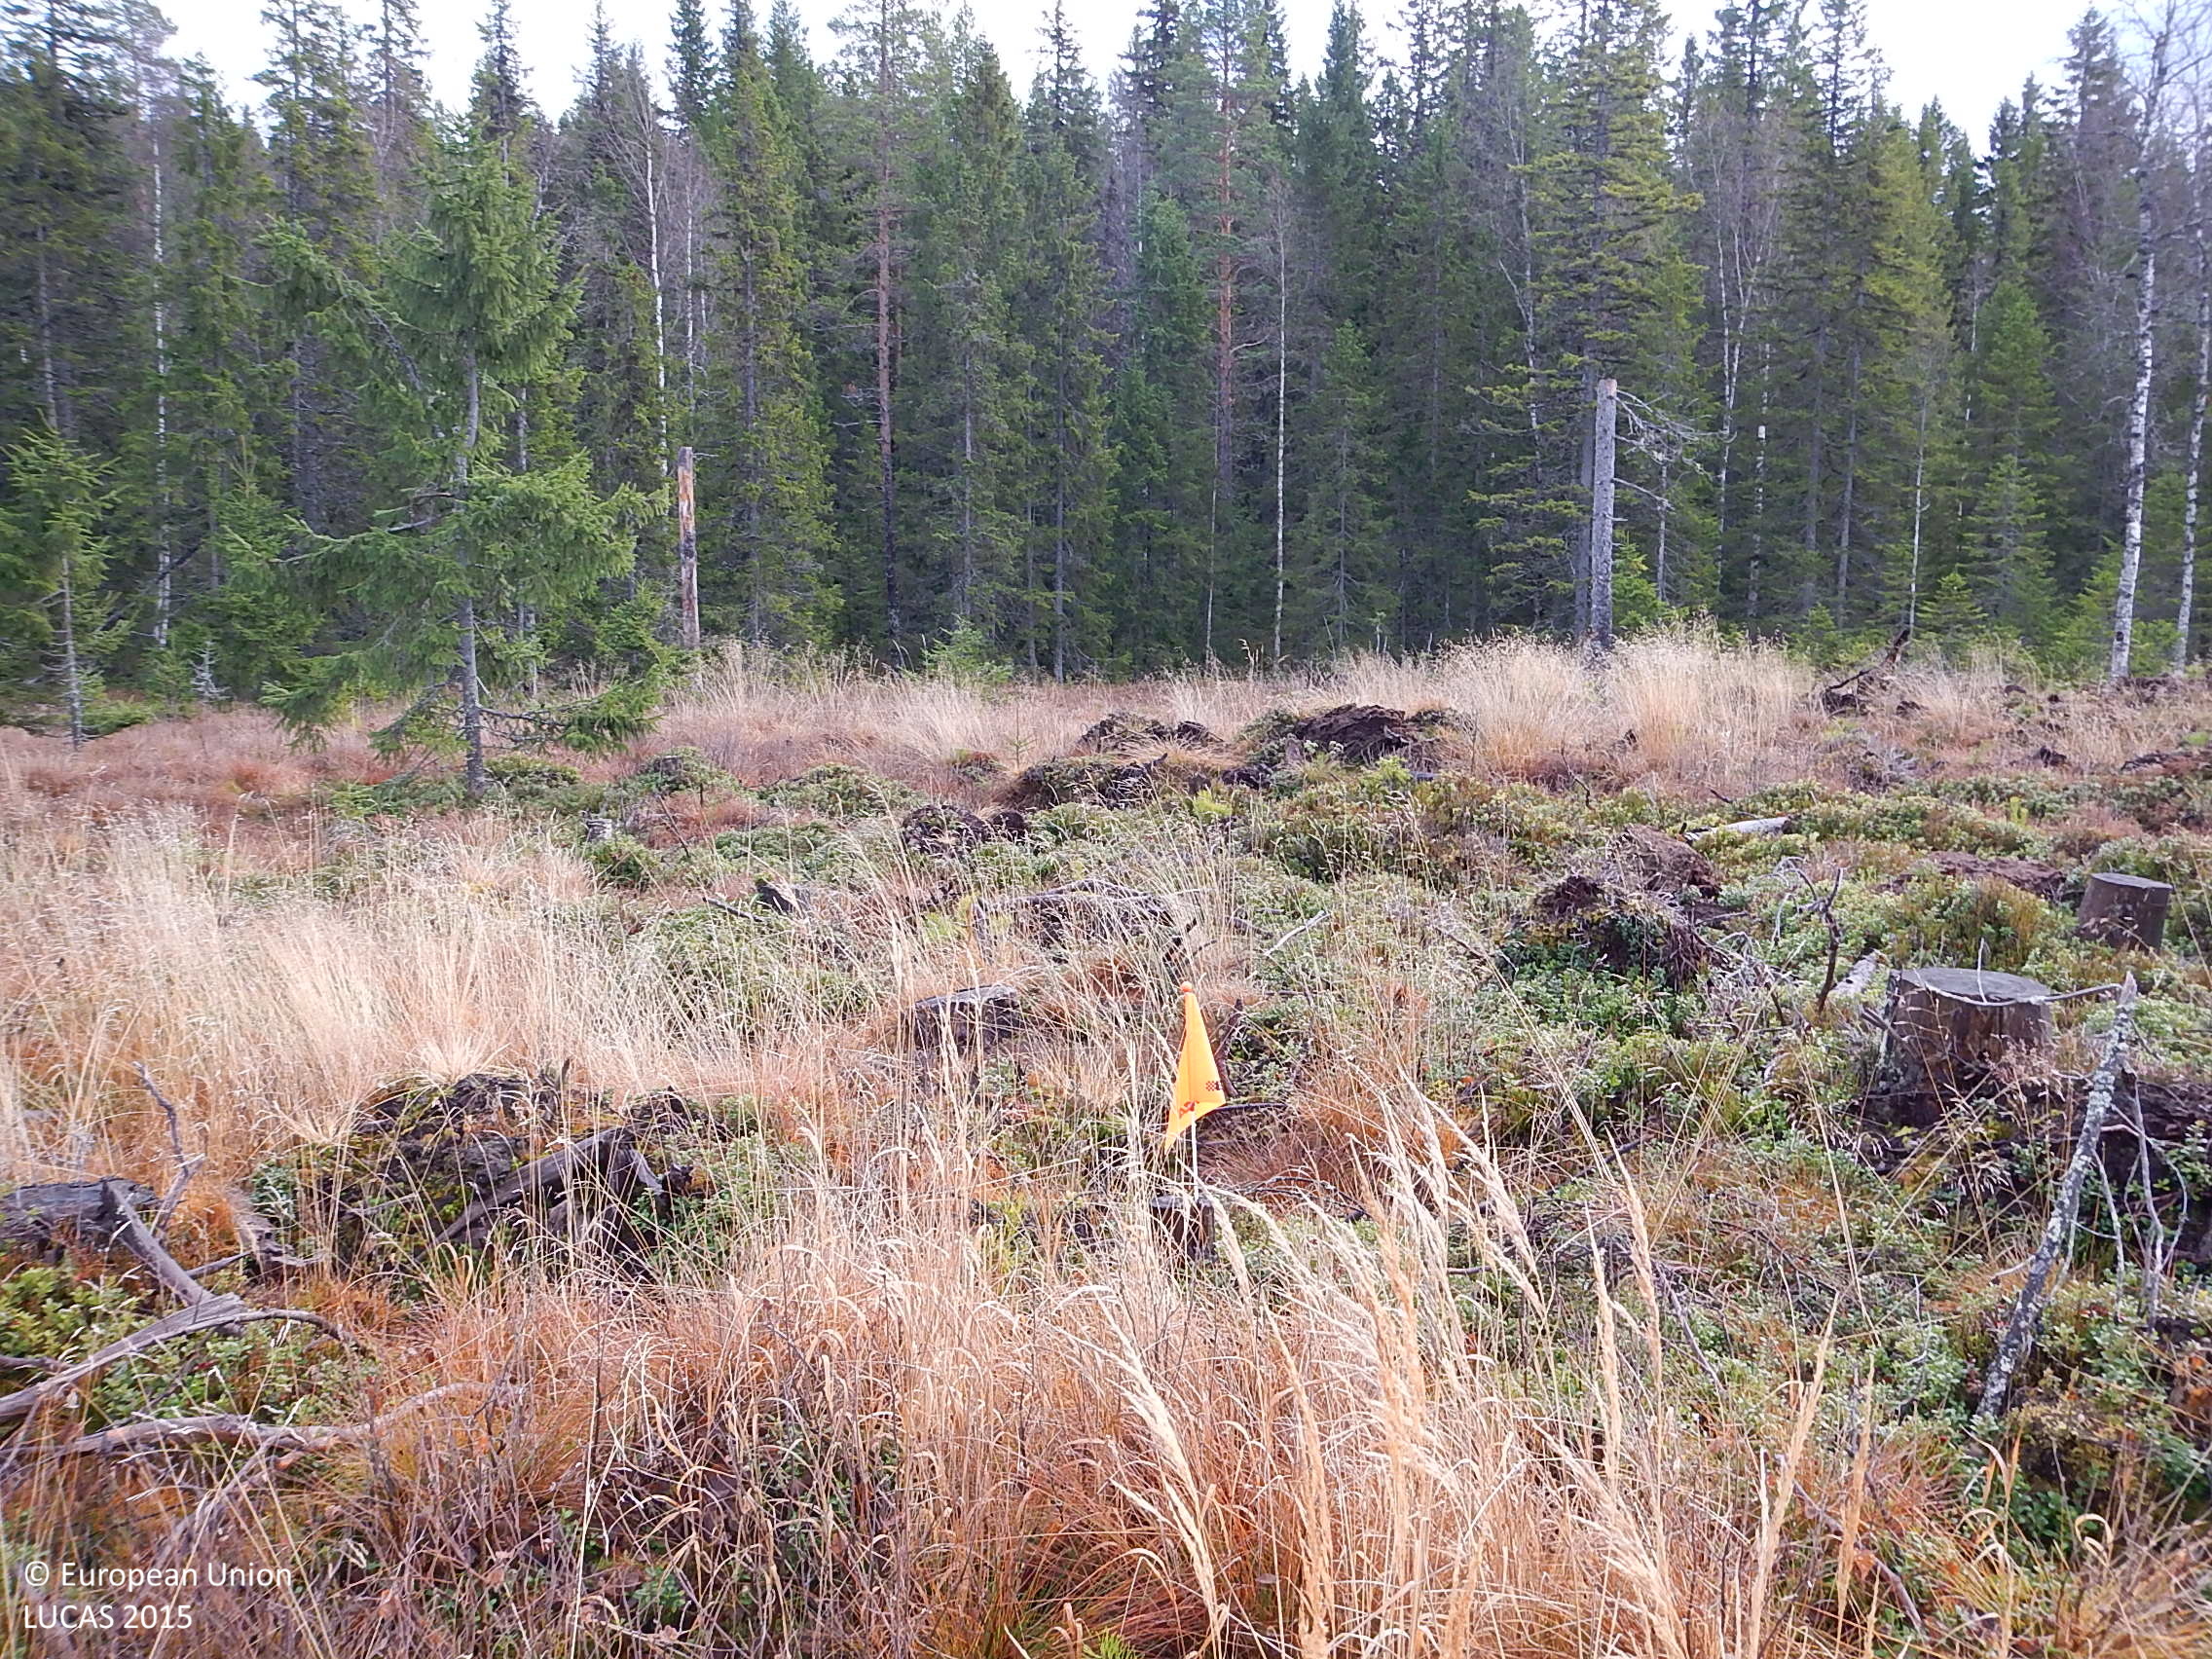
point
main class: Shrubland
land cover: Shrubland with sparse tree cover
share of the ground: > 75 %
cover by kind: shrubs 50 %, herbaceous plants 35 %, coniferous forest trees 5 %, lichens and mosses 5 %, unconsolidated bare surface 5 %
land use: Forestry
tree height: < 5 m
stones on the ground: < 10 %
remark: Clear cut
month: November
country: SE
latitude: 61.1150
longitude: 16.0911
